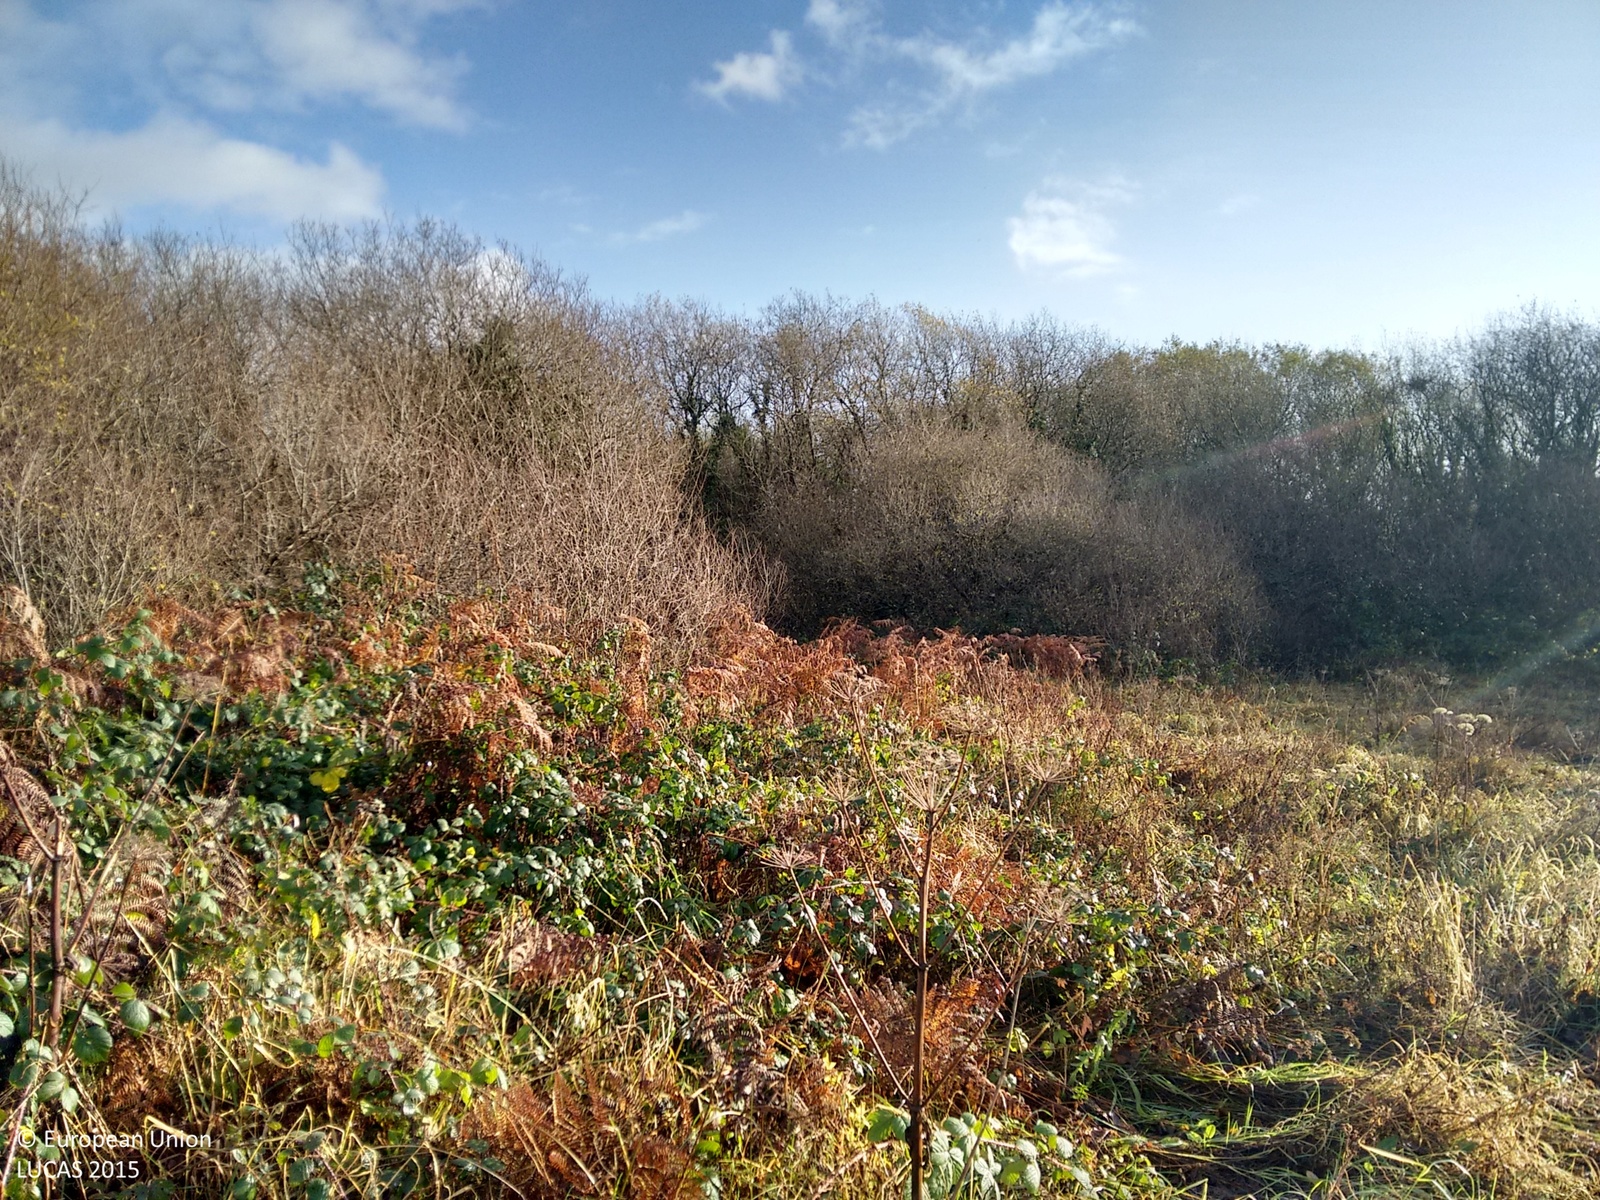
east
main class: Grassland
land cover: Spontaneously vegetated surfaces
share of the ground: > 75 %
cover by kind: herbaceous plants 95 %, shrubs 5 %
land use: Semi-natural and natural areas not in use
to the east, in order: Spontaneously vegetated surfaces; Broadleaved woodland; Shrubland with sparse tree cover; Tracks; Shrubland with sparse tree cover
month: November
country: IE
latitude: 53.9793
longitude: -7.9676
